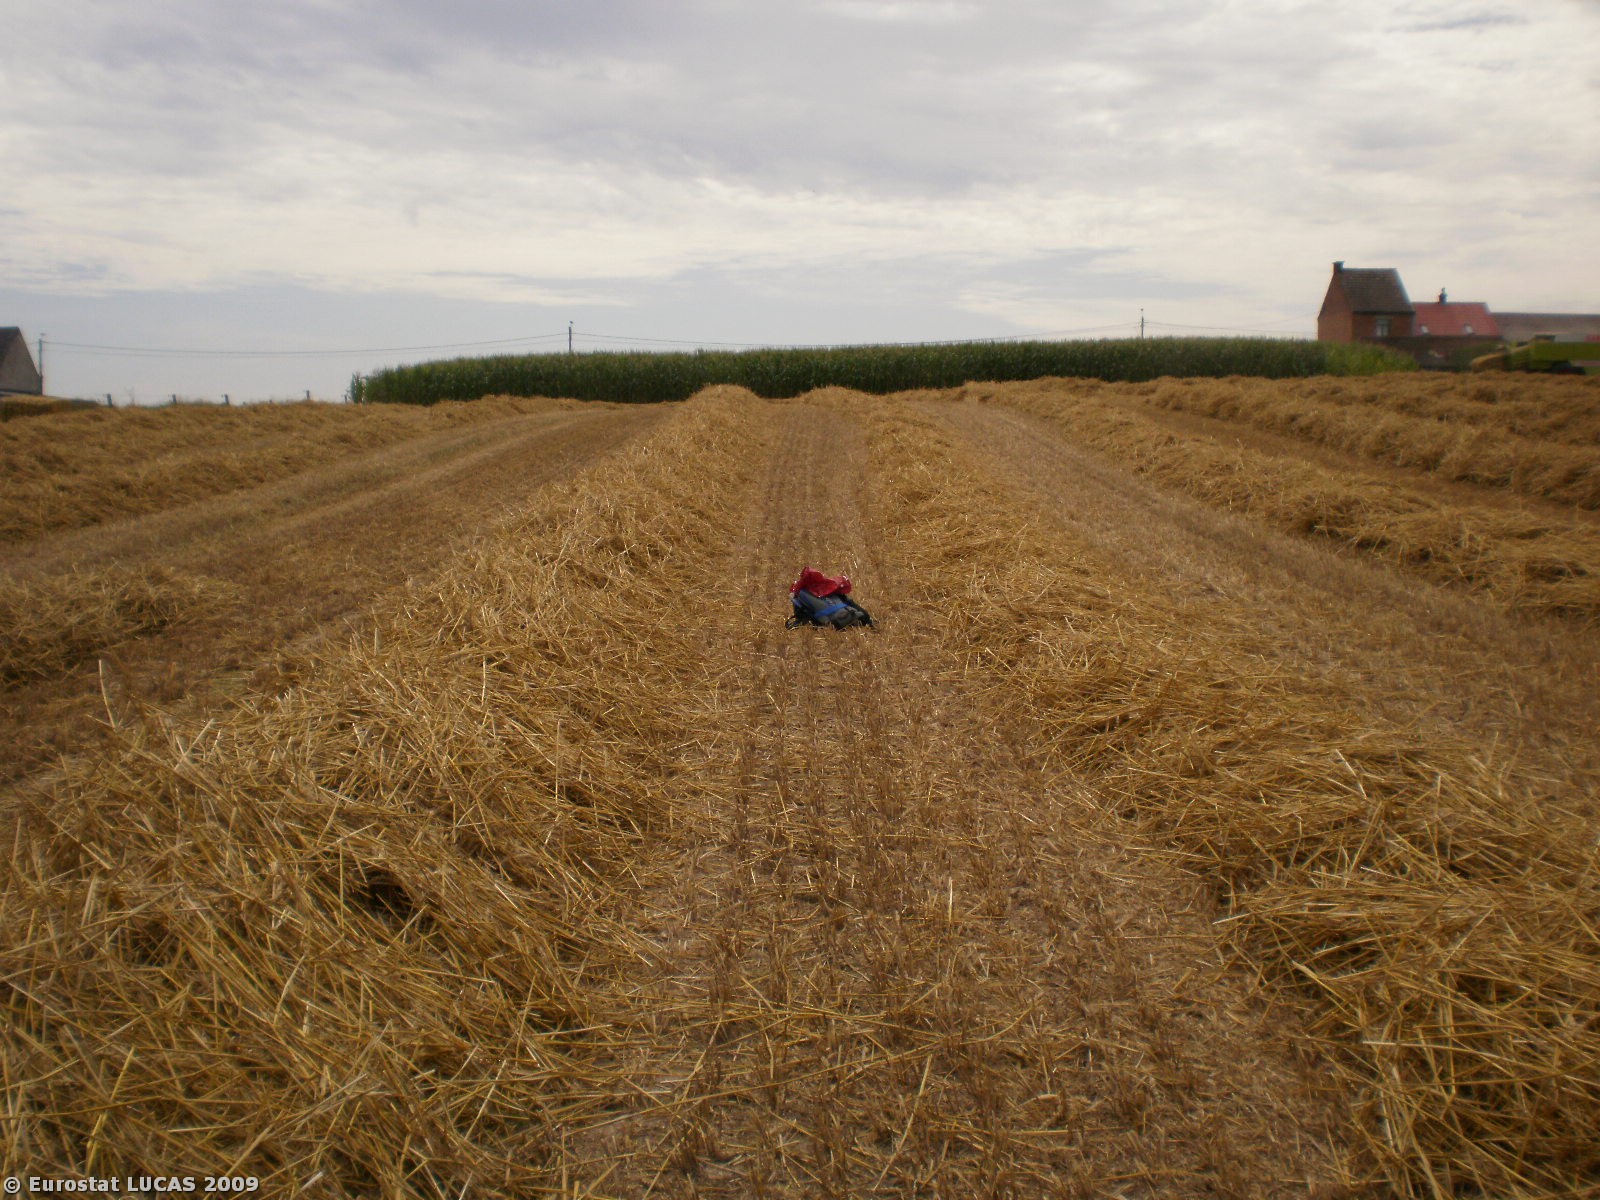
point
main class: Cropland
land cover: Common wheat
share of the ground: > 75 %
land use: Agriculture (excluding fallow land and kitchen gardens)
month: August
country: BE
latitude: 50.7564
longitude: 3.8272
